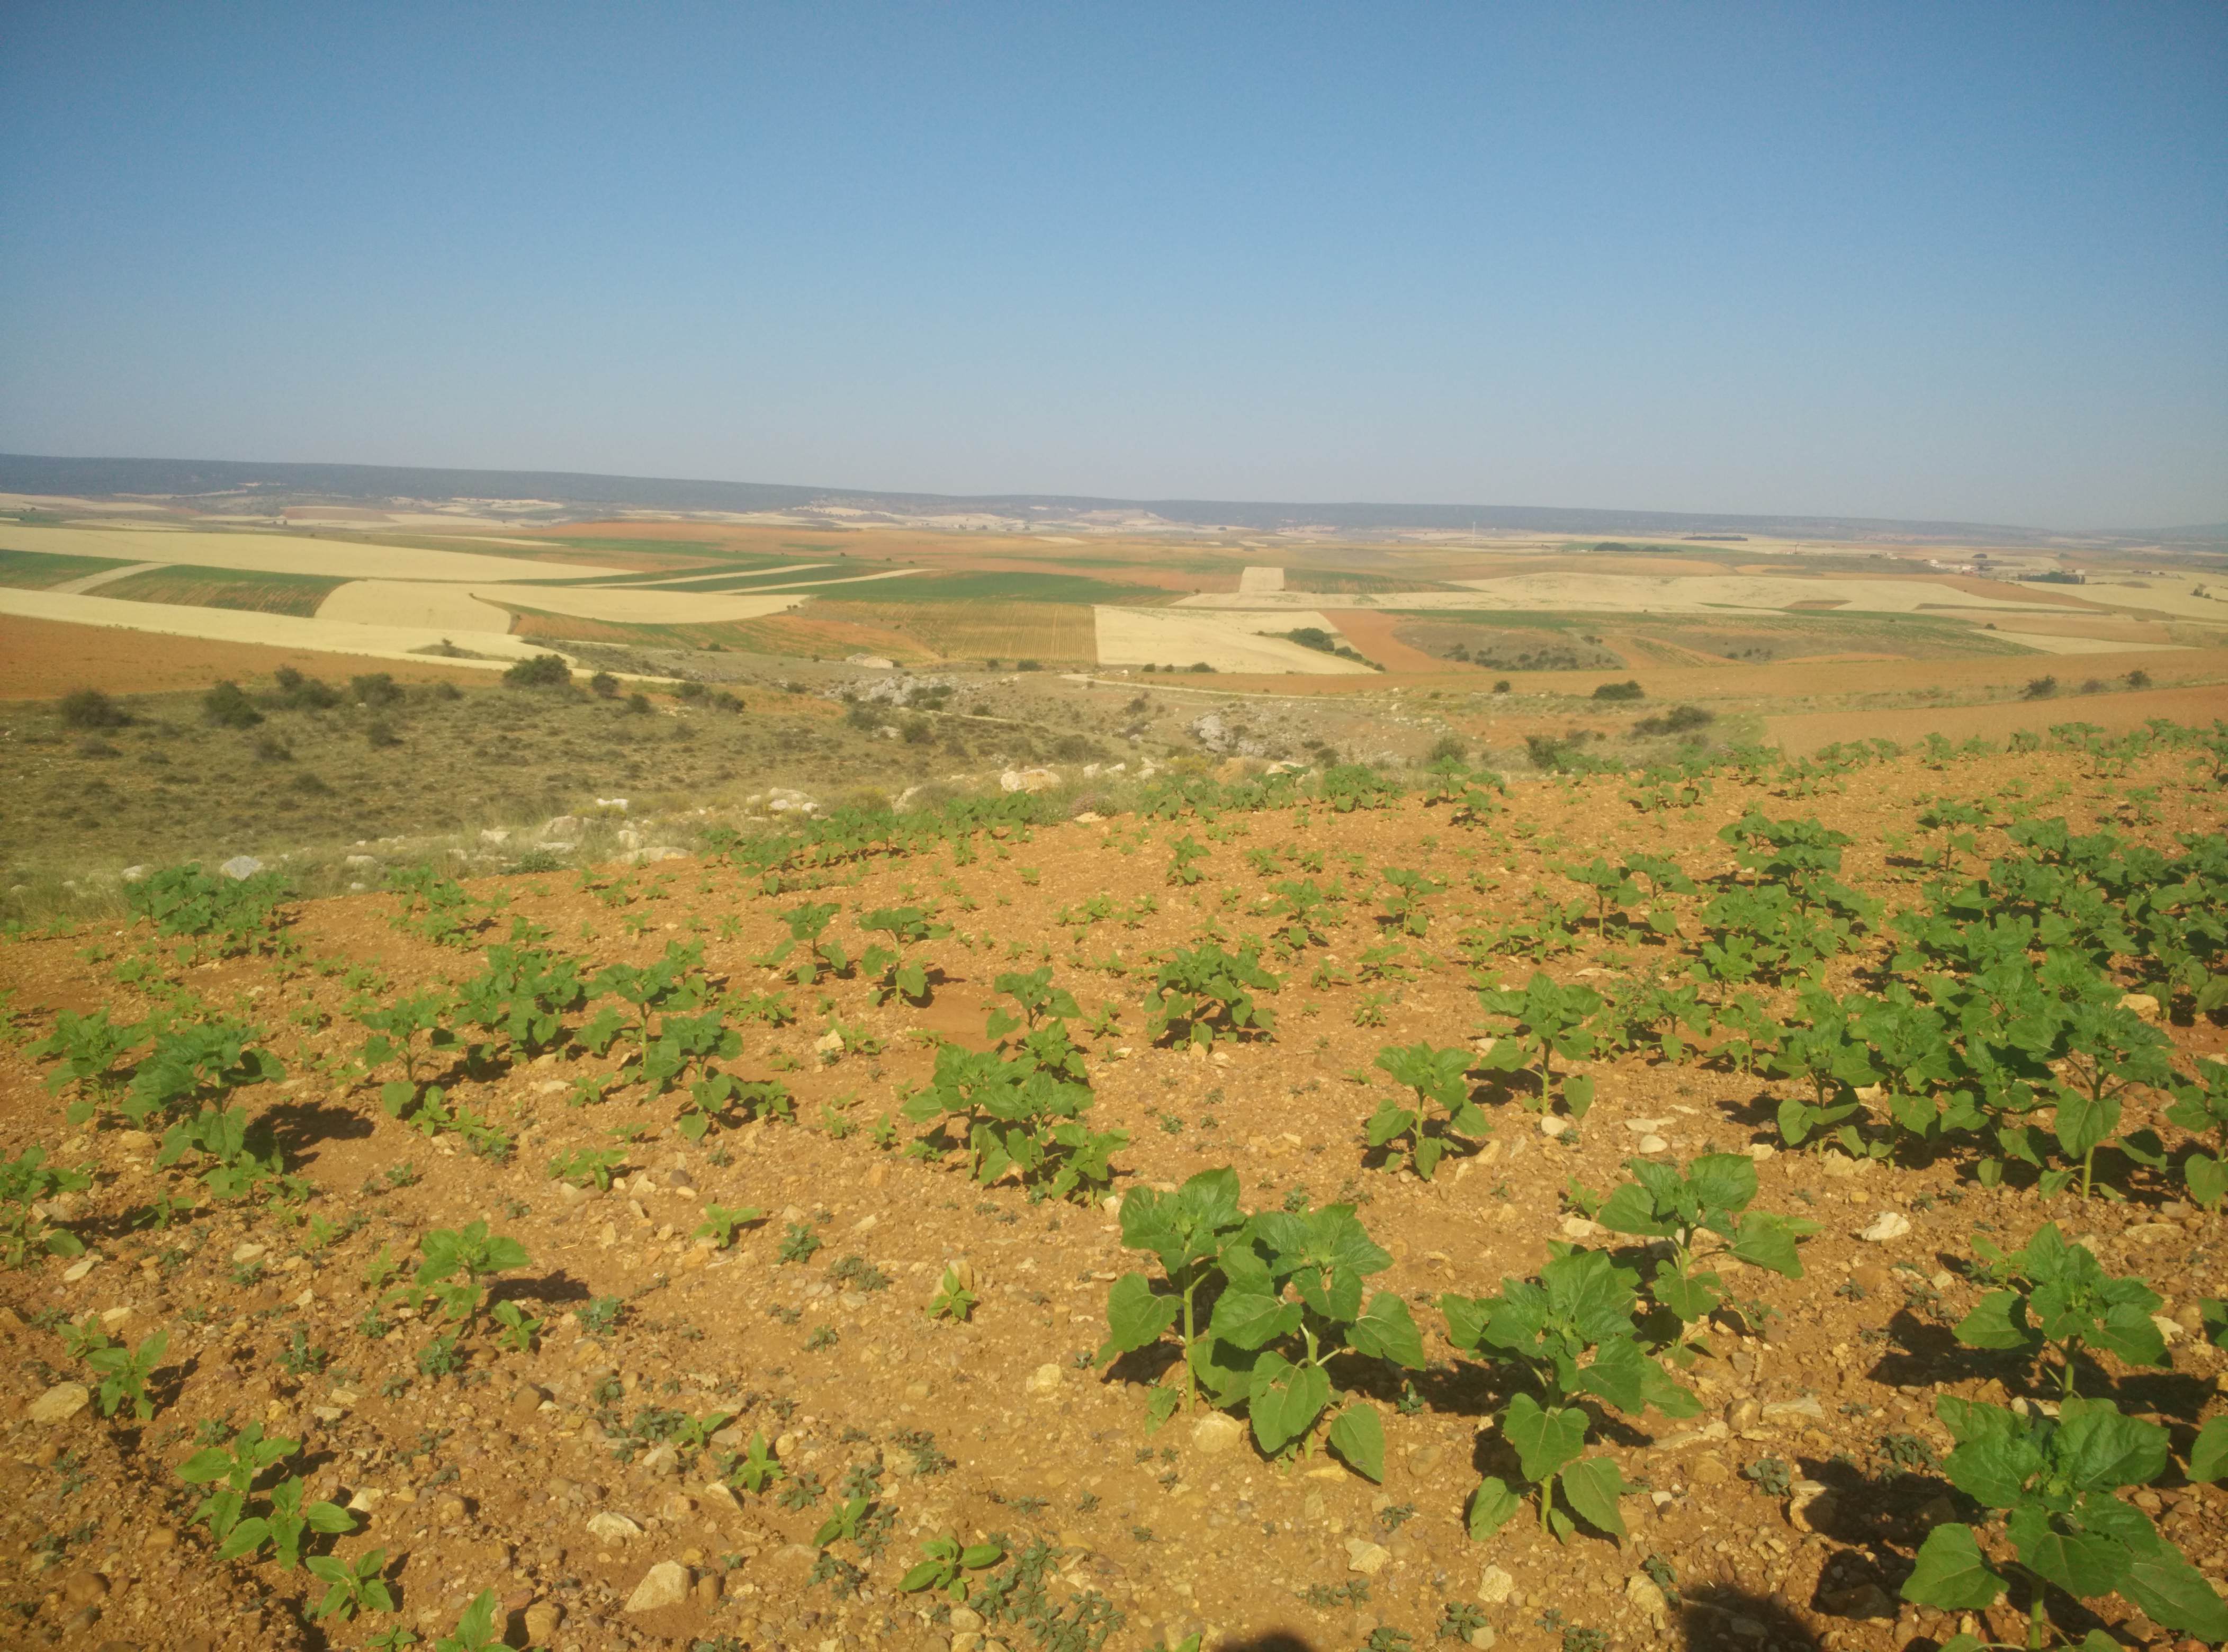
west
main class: Cropland
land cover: Sunflower
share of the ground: 25 - 50 %
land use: Agriculture (excluding fallow land and kitchen gardens)
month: June
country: ES
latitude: 40.7804
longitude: -1.7630
